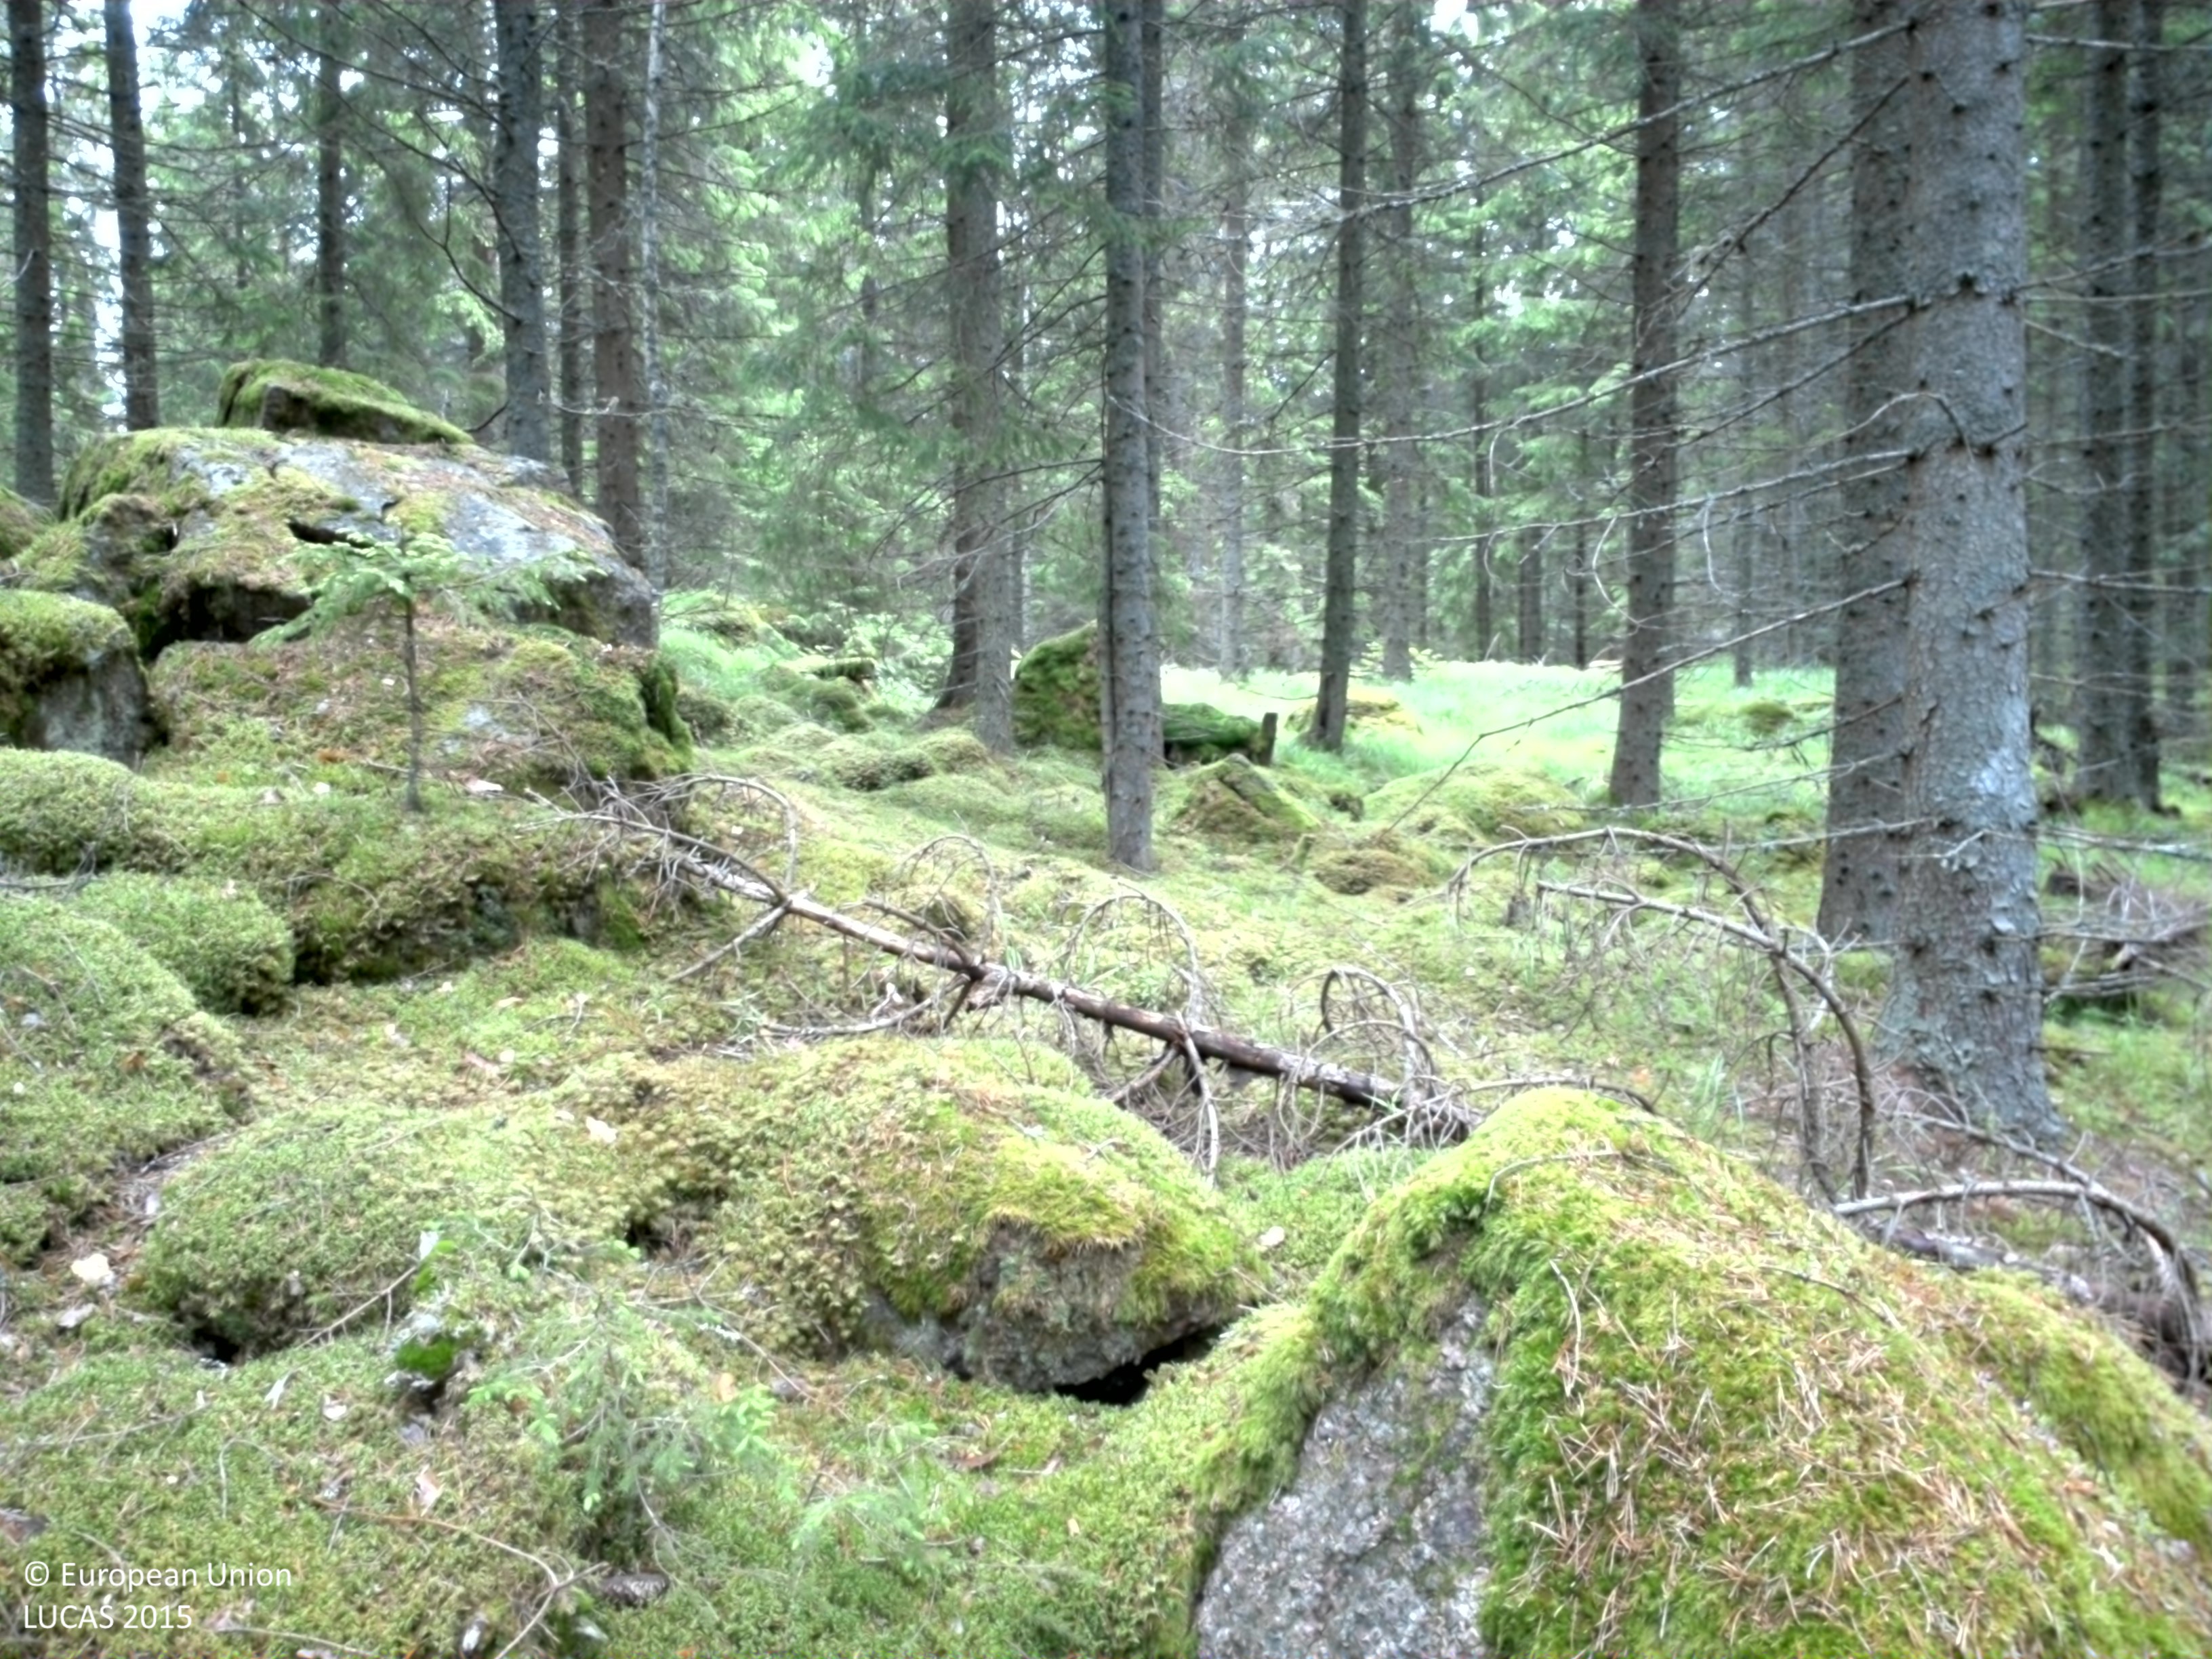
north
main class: Woodland
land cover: Spruce dominated coniferous woodland
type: boreal forest
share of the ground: 25 - 50 %
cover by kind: lichens and mosses 55 %, coniferous forest trees 40 %, herbaceous plants 5 %
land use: Forestry
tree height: > 5 m
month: June
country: SE
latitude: 58.6319
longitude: 15.4537
